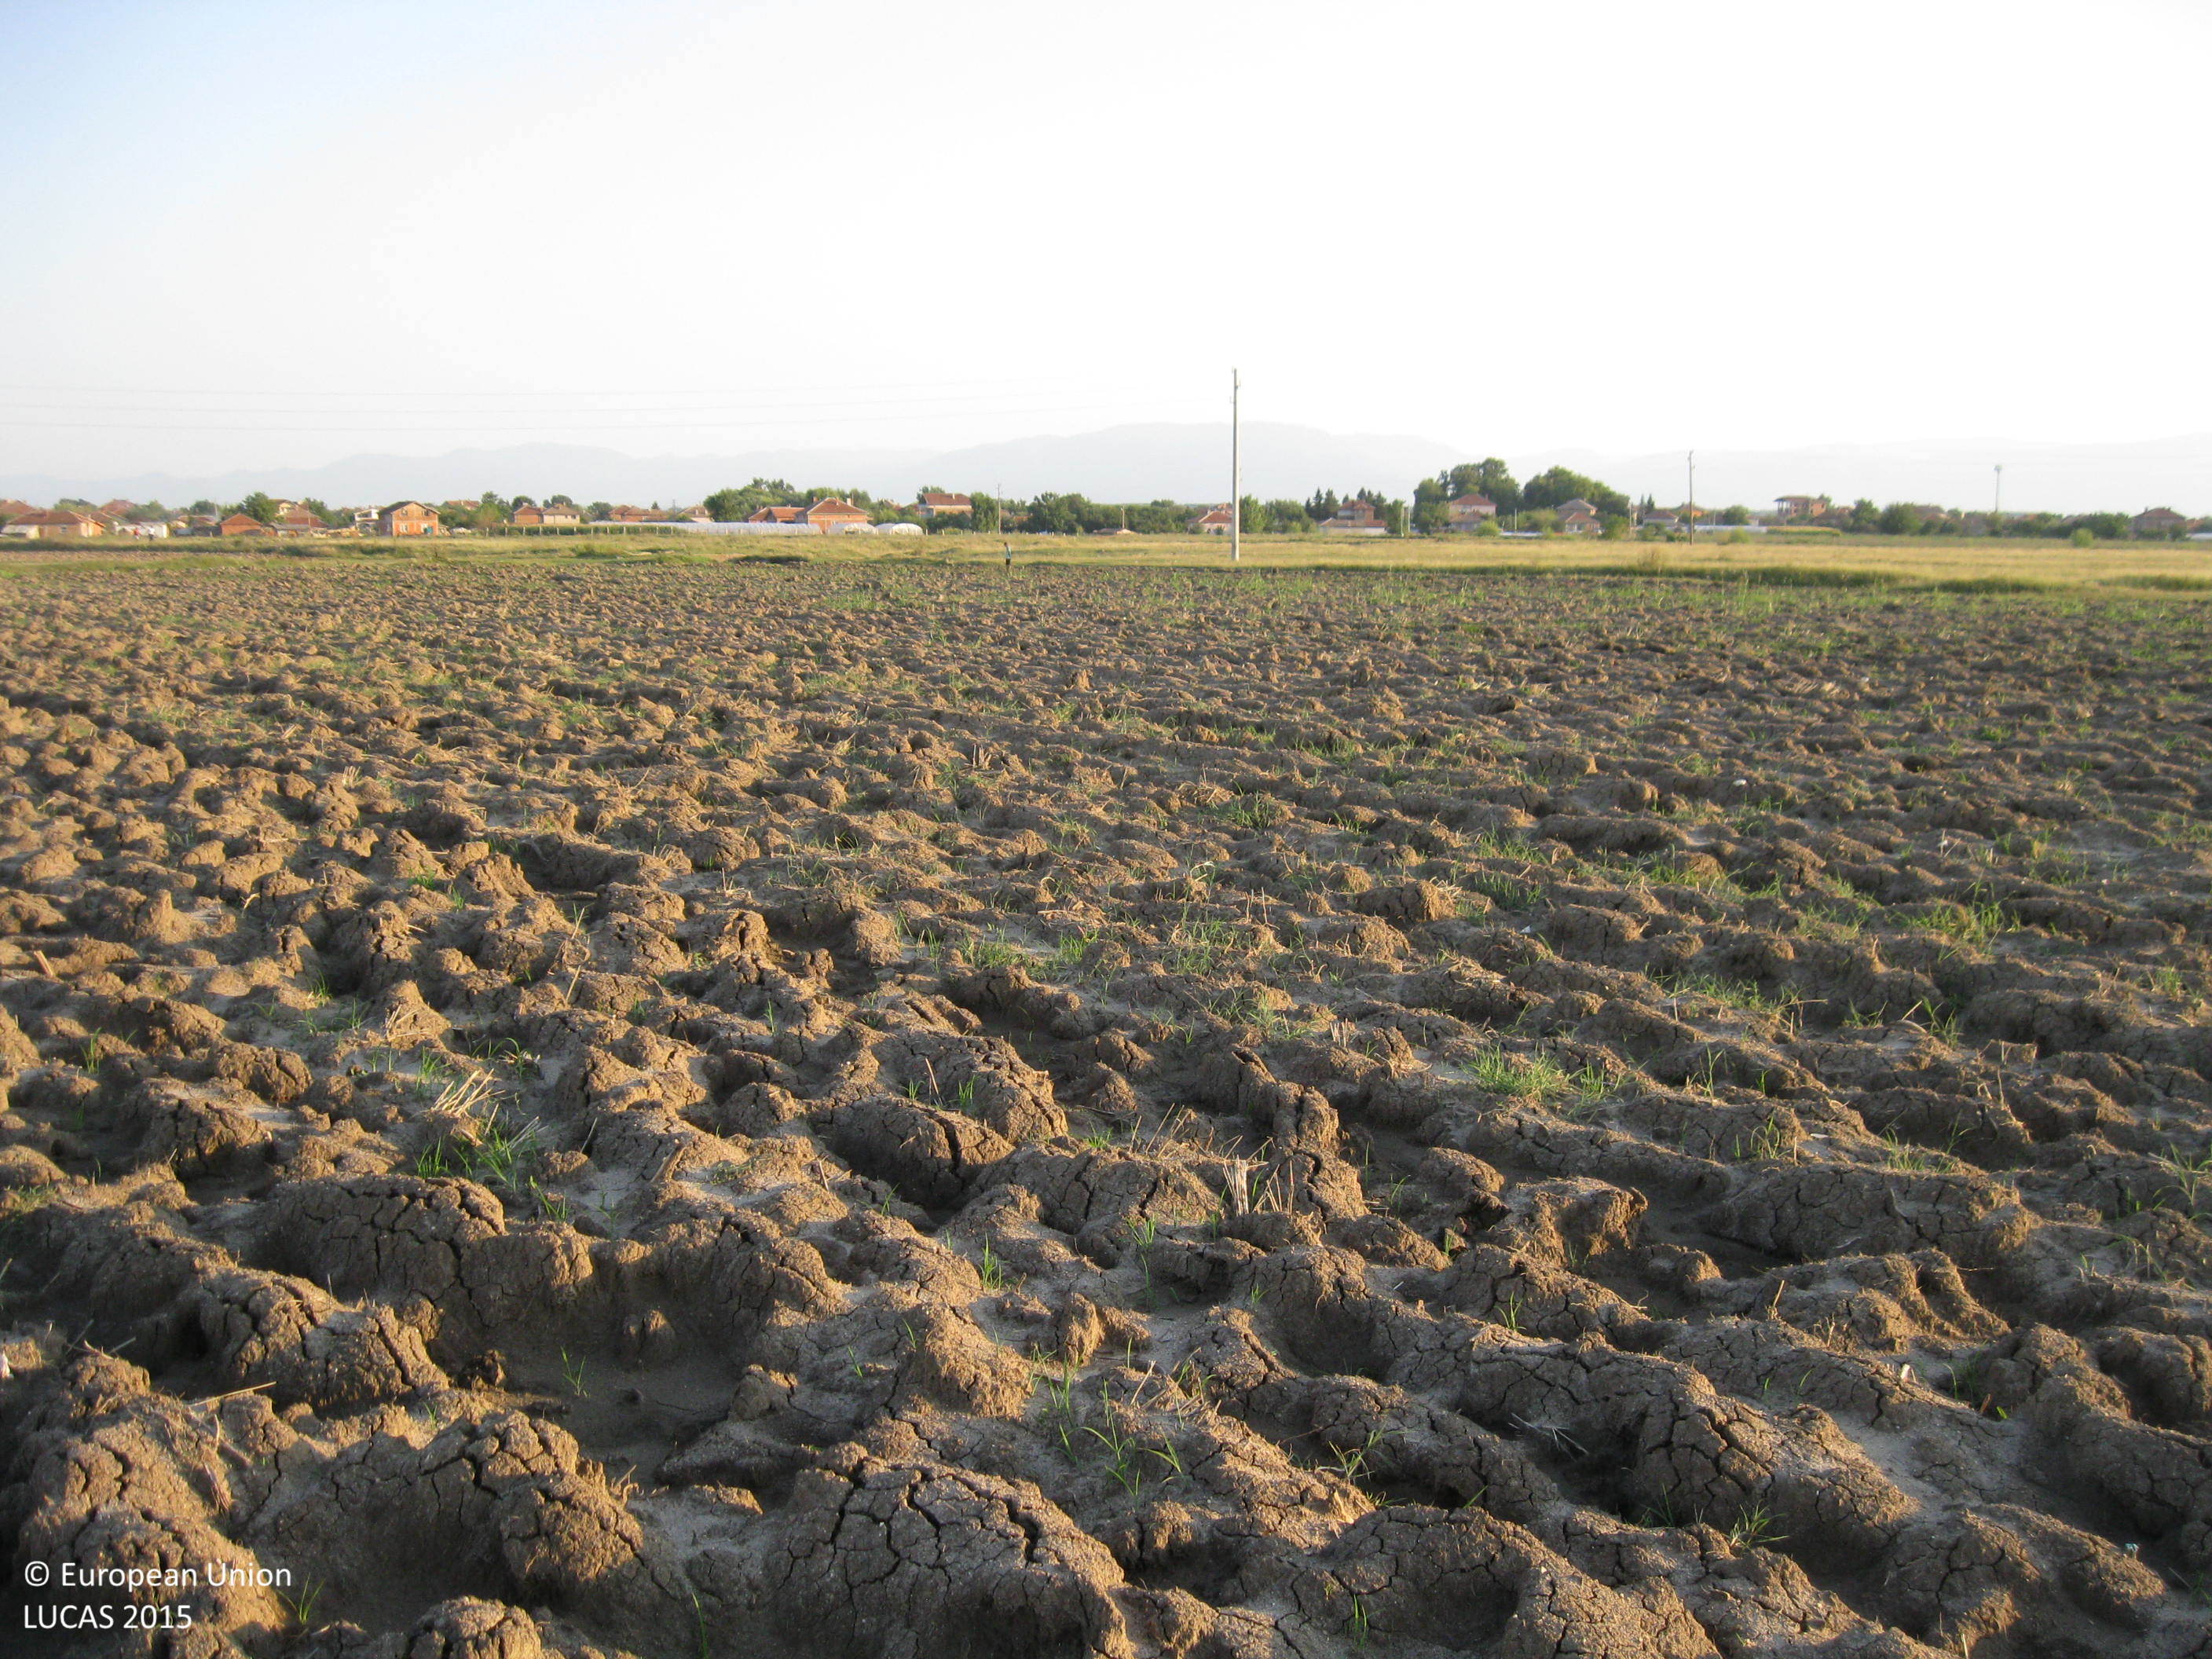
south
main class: Cropland
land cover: Common wheat
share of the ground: < 10 %
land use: Agriculture (excluding fallow land and kitchen gardens)
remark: Harvested field
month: August
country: BG
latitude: 42.1989
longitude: 24.9395
